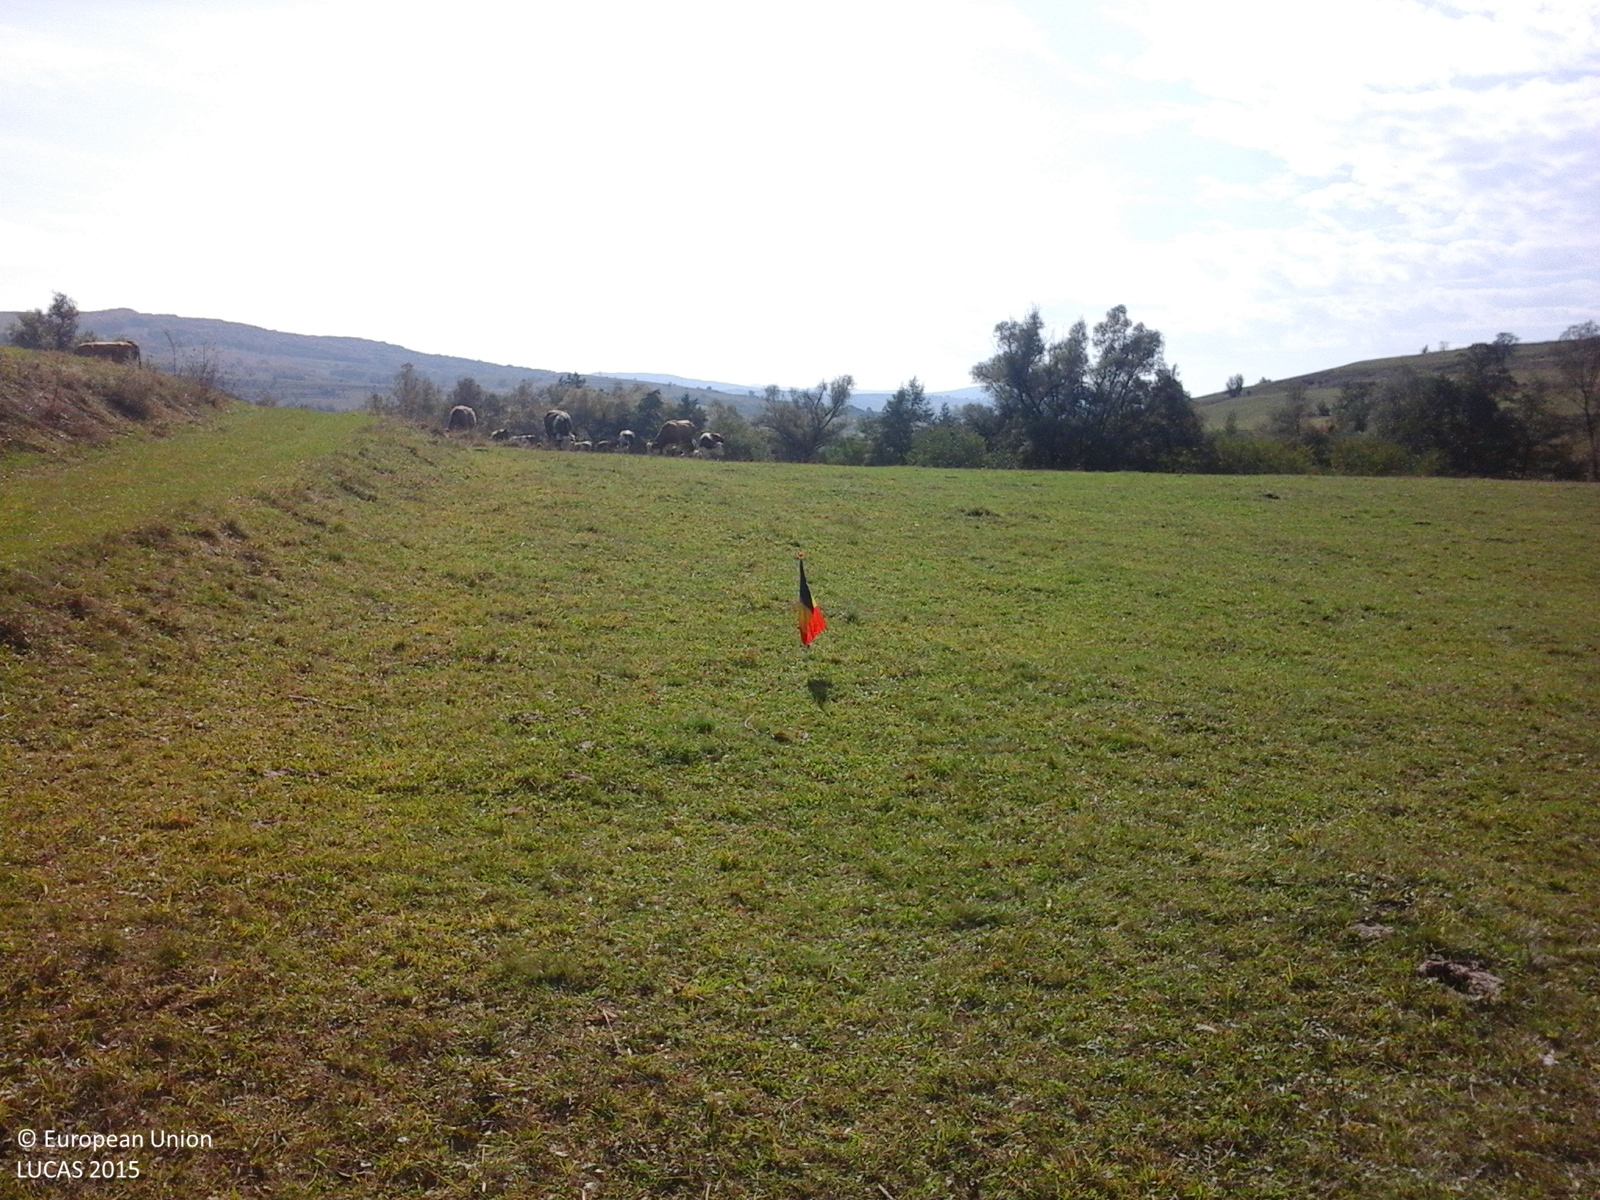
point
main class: Grassland
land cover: Grassland without tree/shrub cover
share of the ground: > 75 %
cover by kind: herbaceous plants 100 %
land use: Agriculture (excluding fallow land and kitchen gardens)
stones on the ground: < 10 %
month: October
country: RO
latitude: 46.0356
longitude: 25.3879
